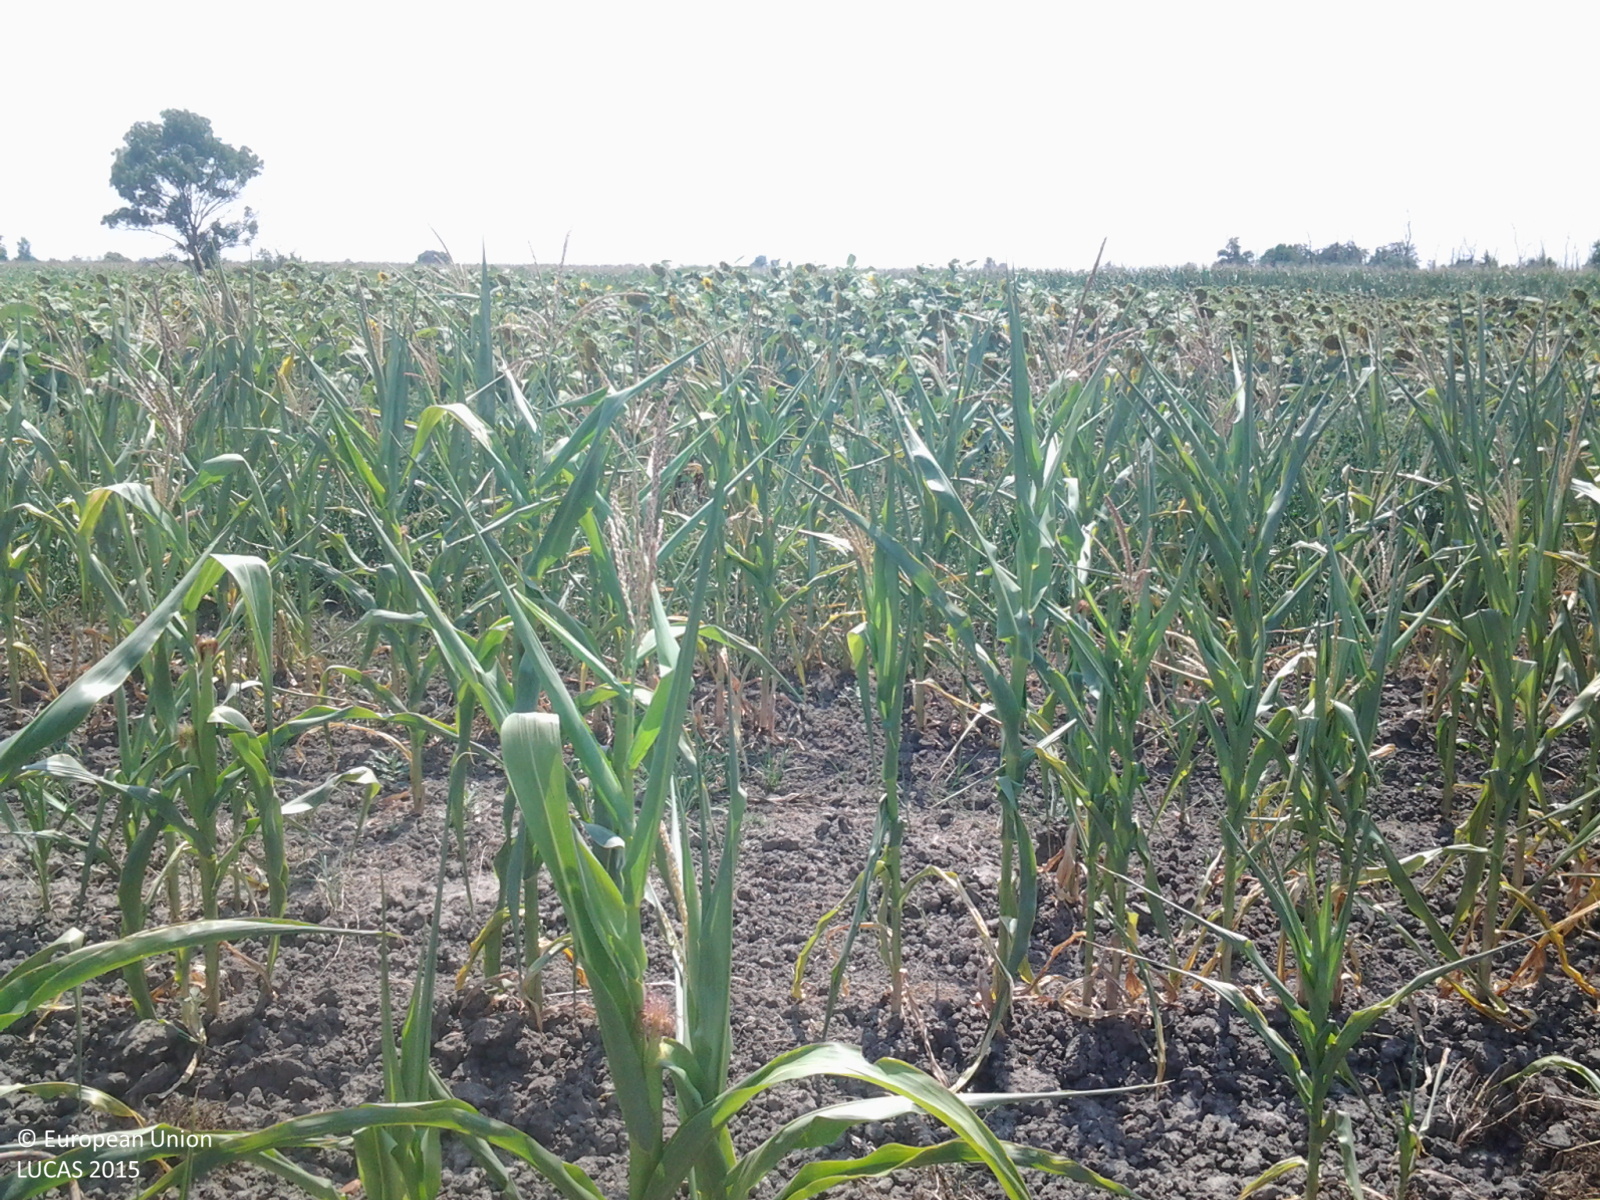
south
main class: Cropland
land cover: Maize
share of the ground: > 75 %
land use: Agriculture (excluding fallow land and kitchen gardens)
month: July
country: HU
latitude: 46.8216
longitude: 21.4822
